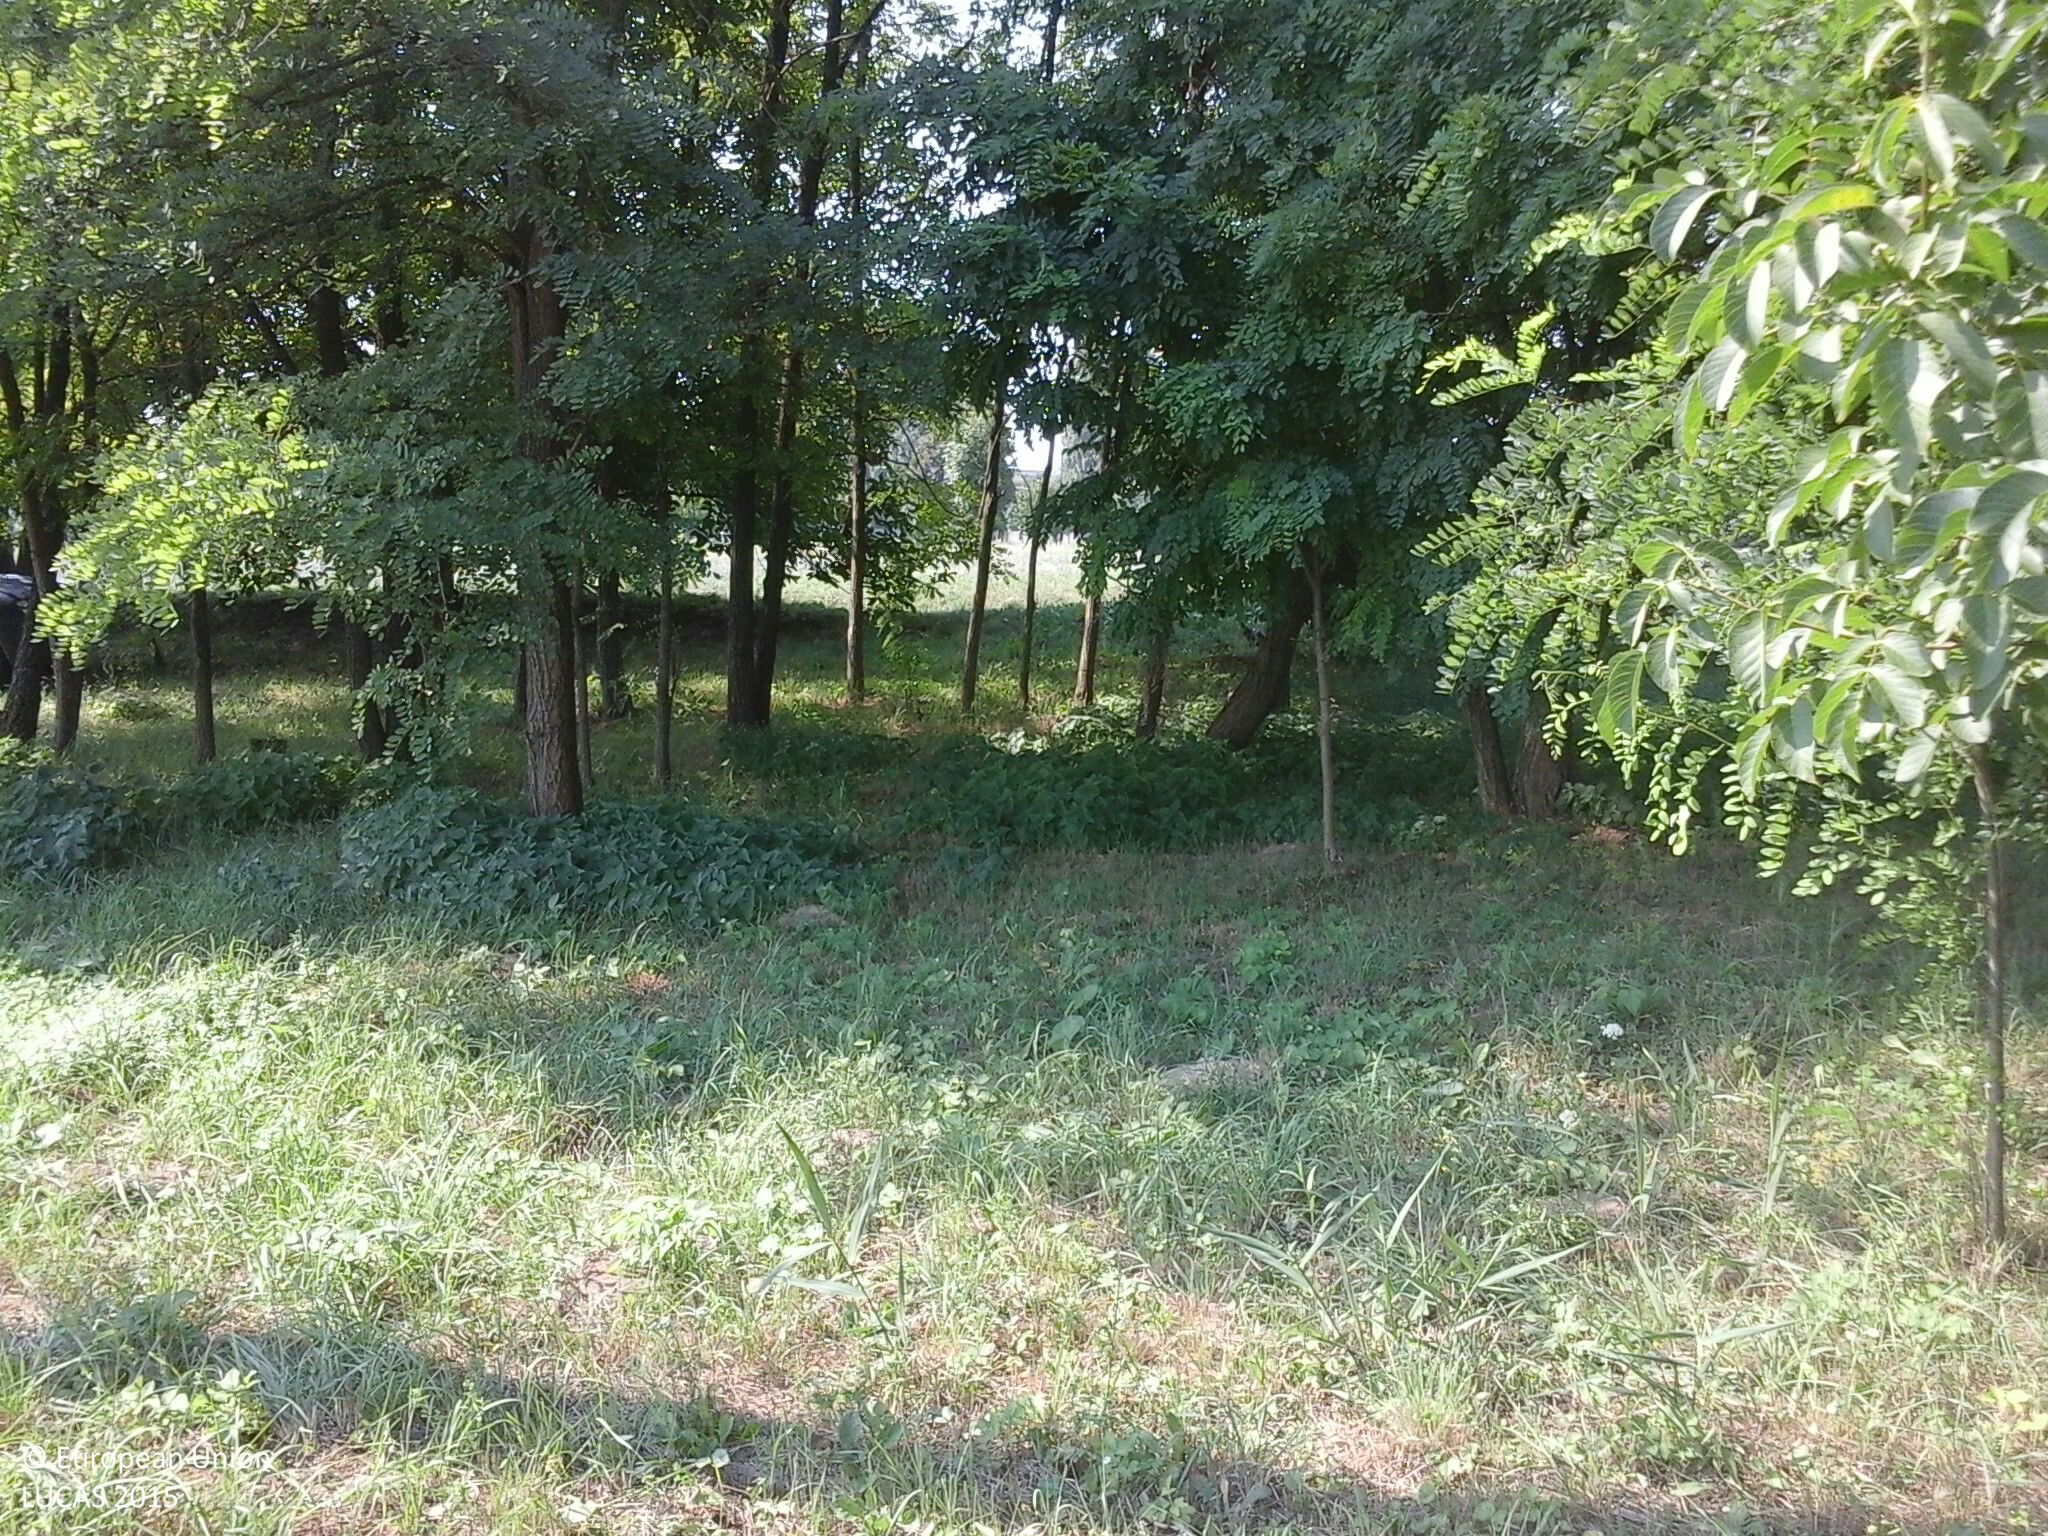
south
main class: Grassland
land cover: Grassland with sparse tree/shrub cover
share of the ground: > 75 %
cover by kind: herbaceous plants 95 %, broadleaved forest trees 5 %
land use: Abandoned areas
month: August
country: HU
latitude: 46.0510
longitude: 18.2399
